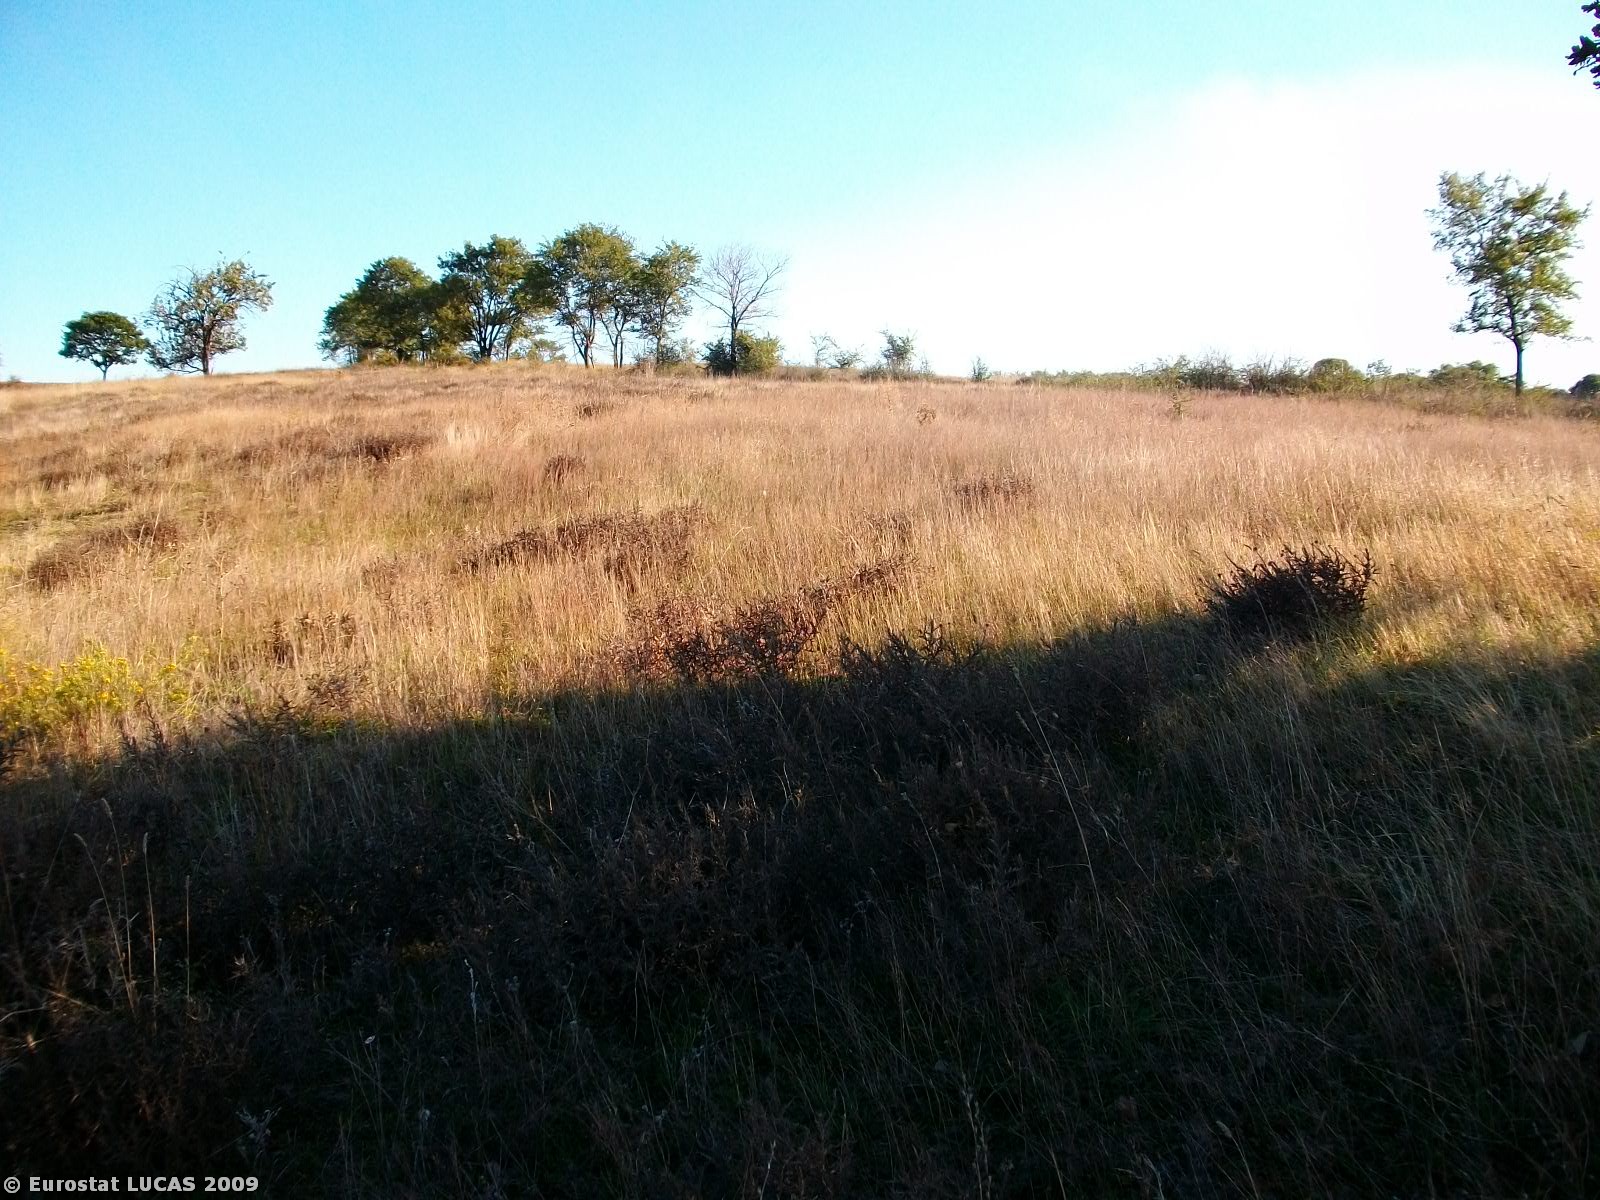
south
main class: Grassland
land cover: Spontaneously vegetated surfaces
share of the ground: 50 - 75 %
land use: Fallow land
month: October
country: GR
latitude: 41.4530
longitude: 26.5144
